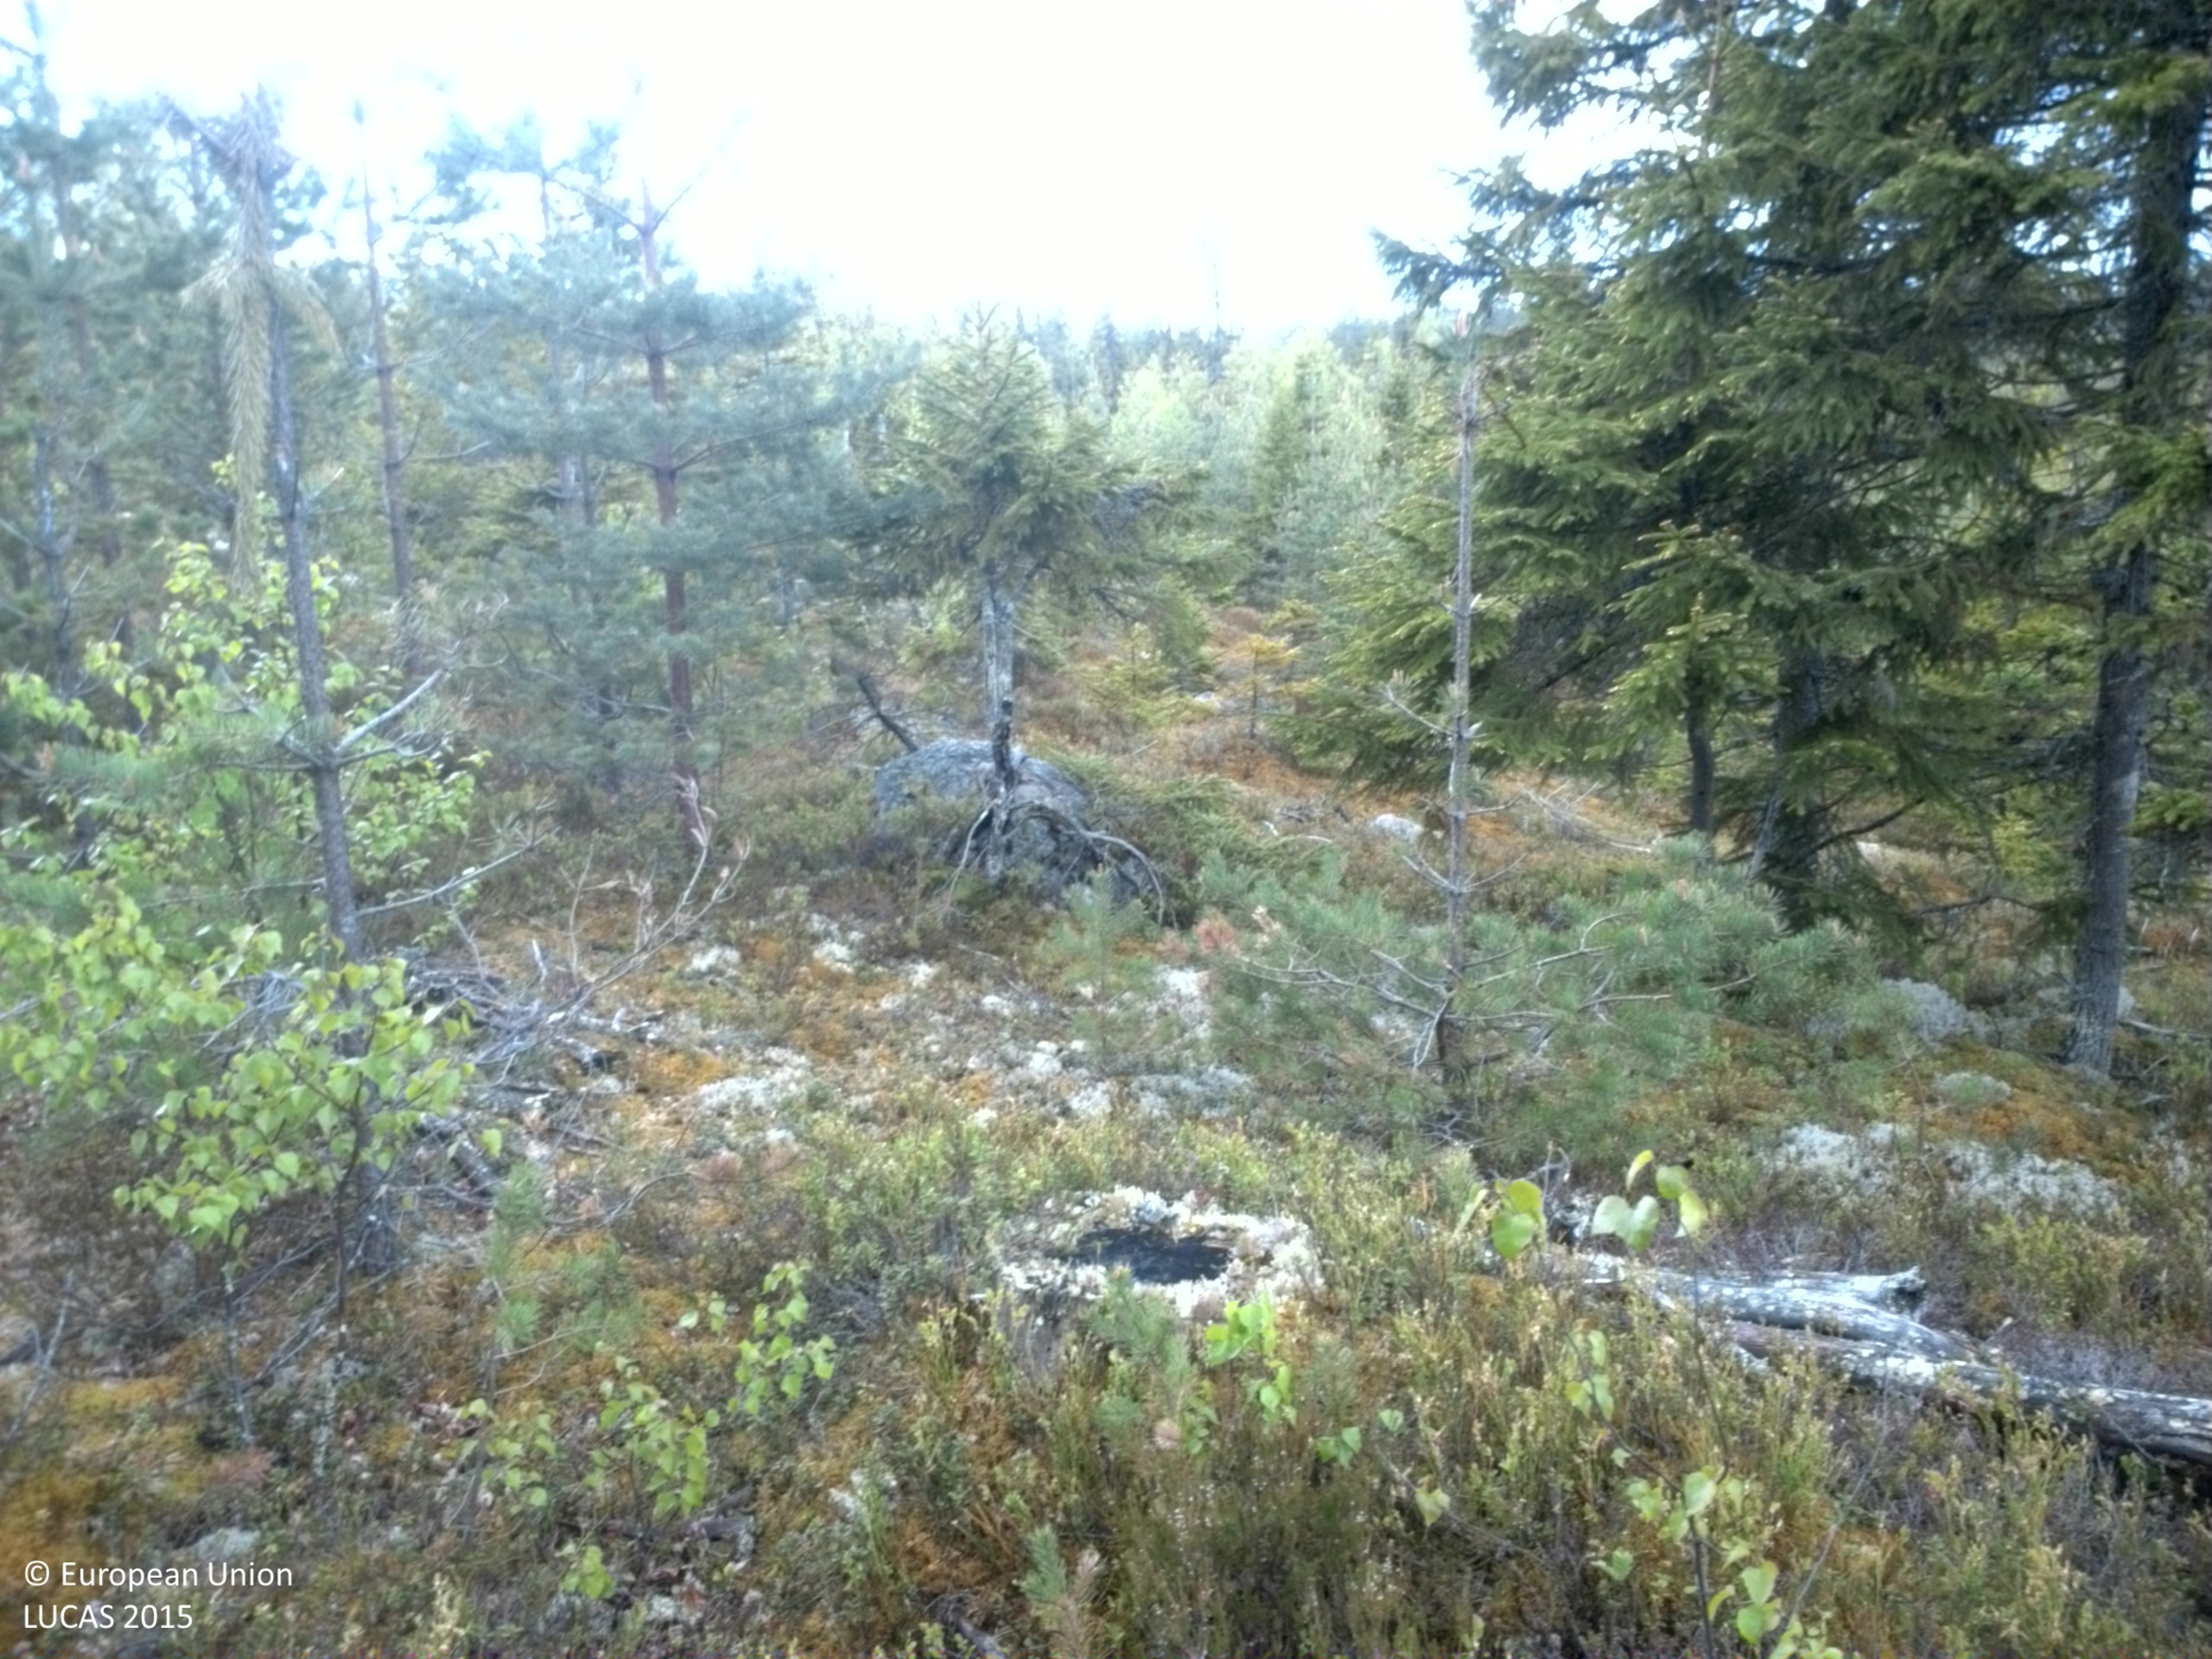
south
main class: Woodland
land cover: Pine dominated mixed woodland
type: boreal forest
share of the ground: 50 - 75 %
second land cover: Shrubland without tree cover
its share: 25 - 50 %
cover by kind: shrubs 40 %, coniferous forest trees 30 %, broadleaved forest trees 20 %, lichens and mosses 10 %
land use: Forestry
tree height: < 5 m
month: June
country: SE
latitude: 63.0871
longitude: 17.6801
